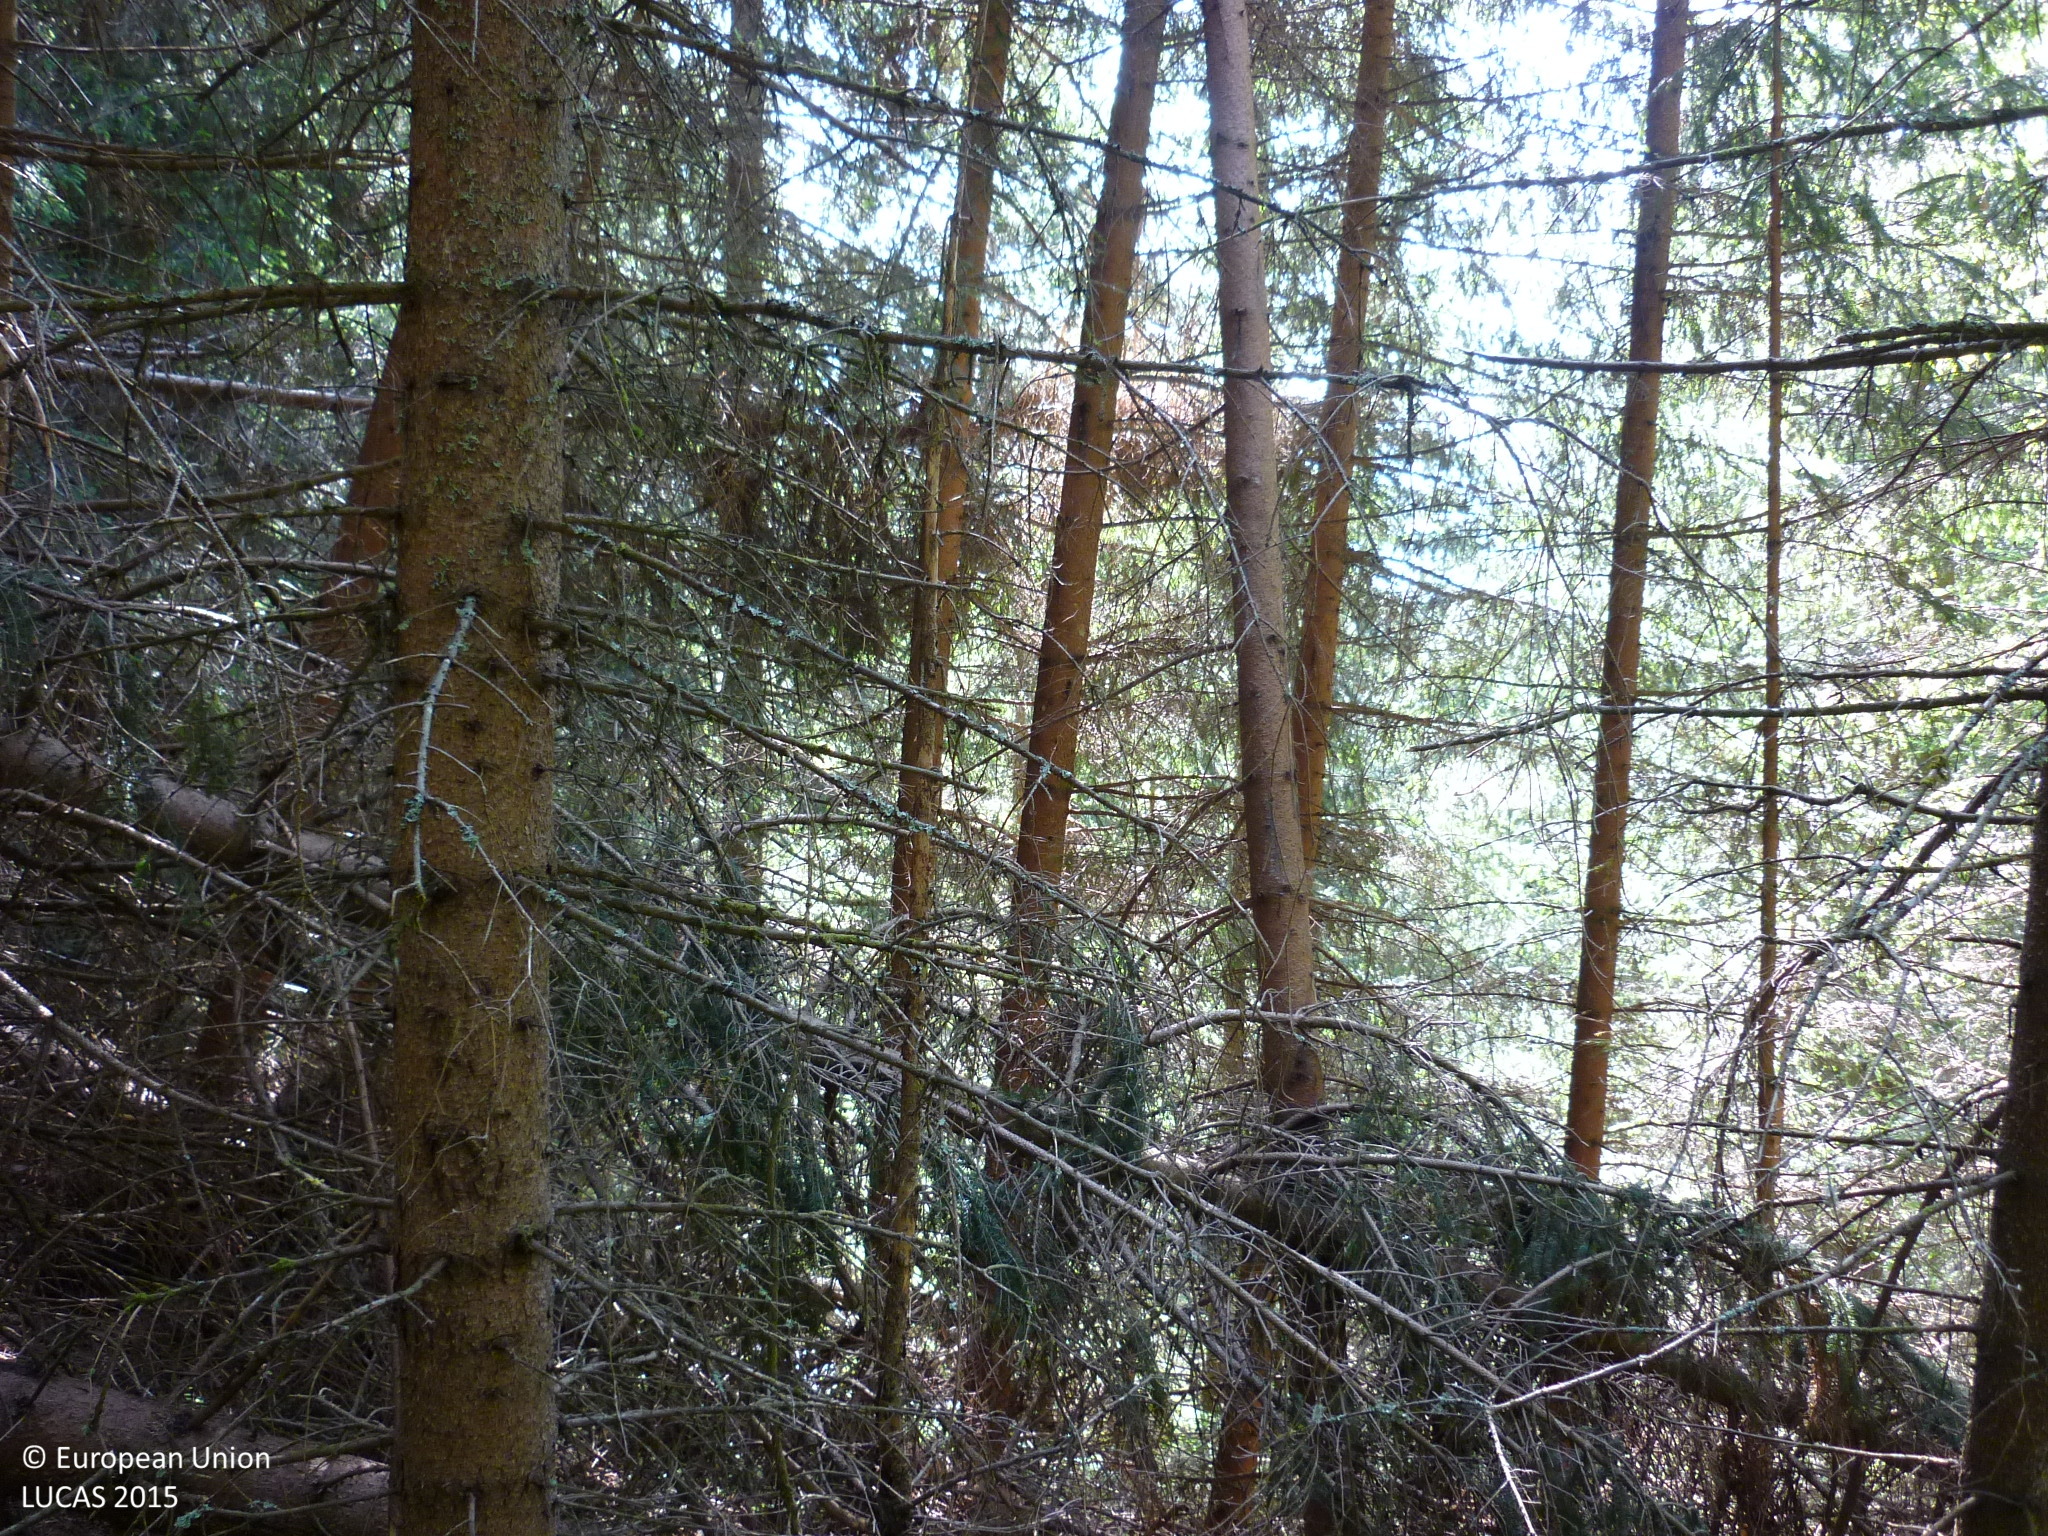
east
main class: Woodland
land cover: Spruce dominated coniferous woodland
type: alpine coniferous forest
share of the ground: > 75 %
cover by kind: coniferous forest trees 85 %, herbaceous plants 10 %, broadleaved forest trees 5 %
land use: Forestry
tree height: > 5 m
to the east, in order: Spruce dominated coniferous woodland; Rivers and streams; Spruce dominated coniferous woodland
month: July
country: AT
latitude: 47.0810
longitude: 14.6216
